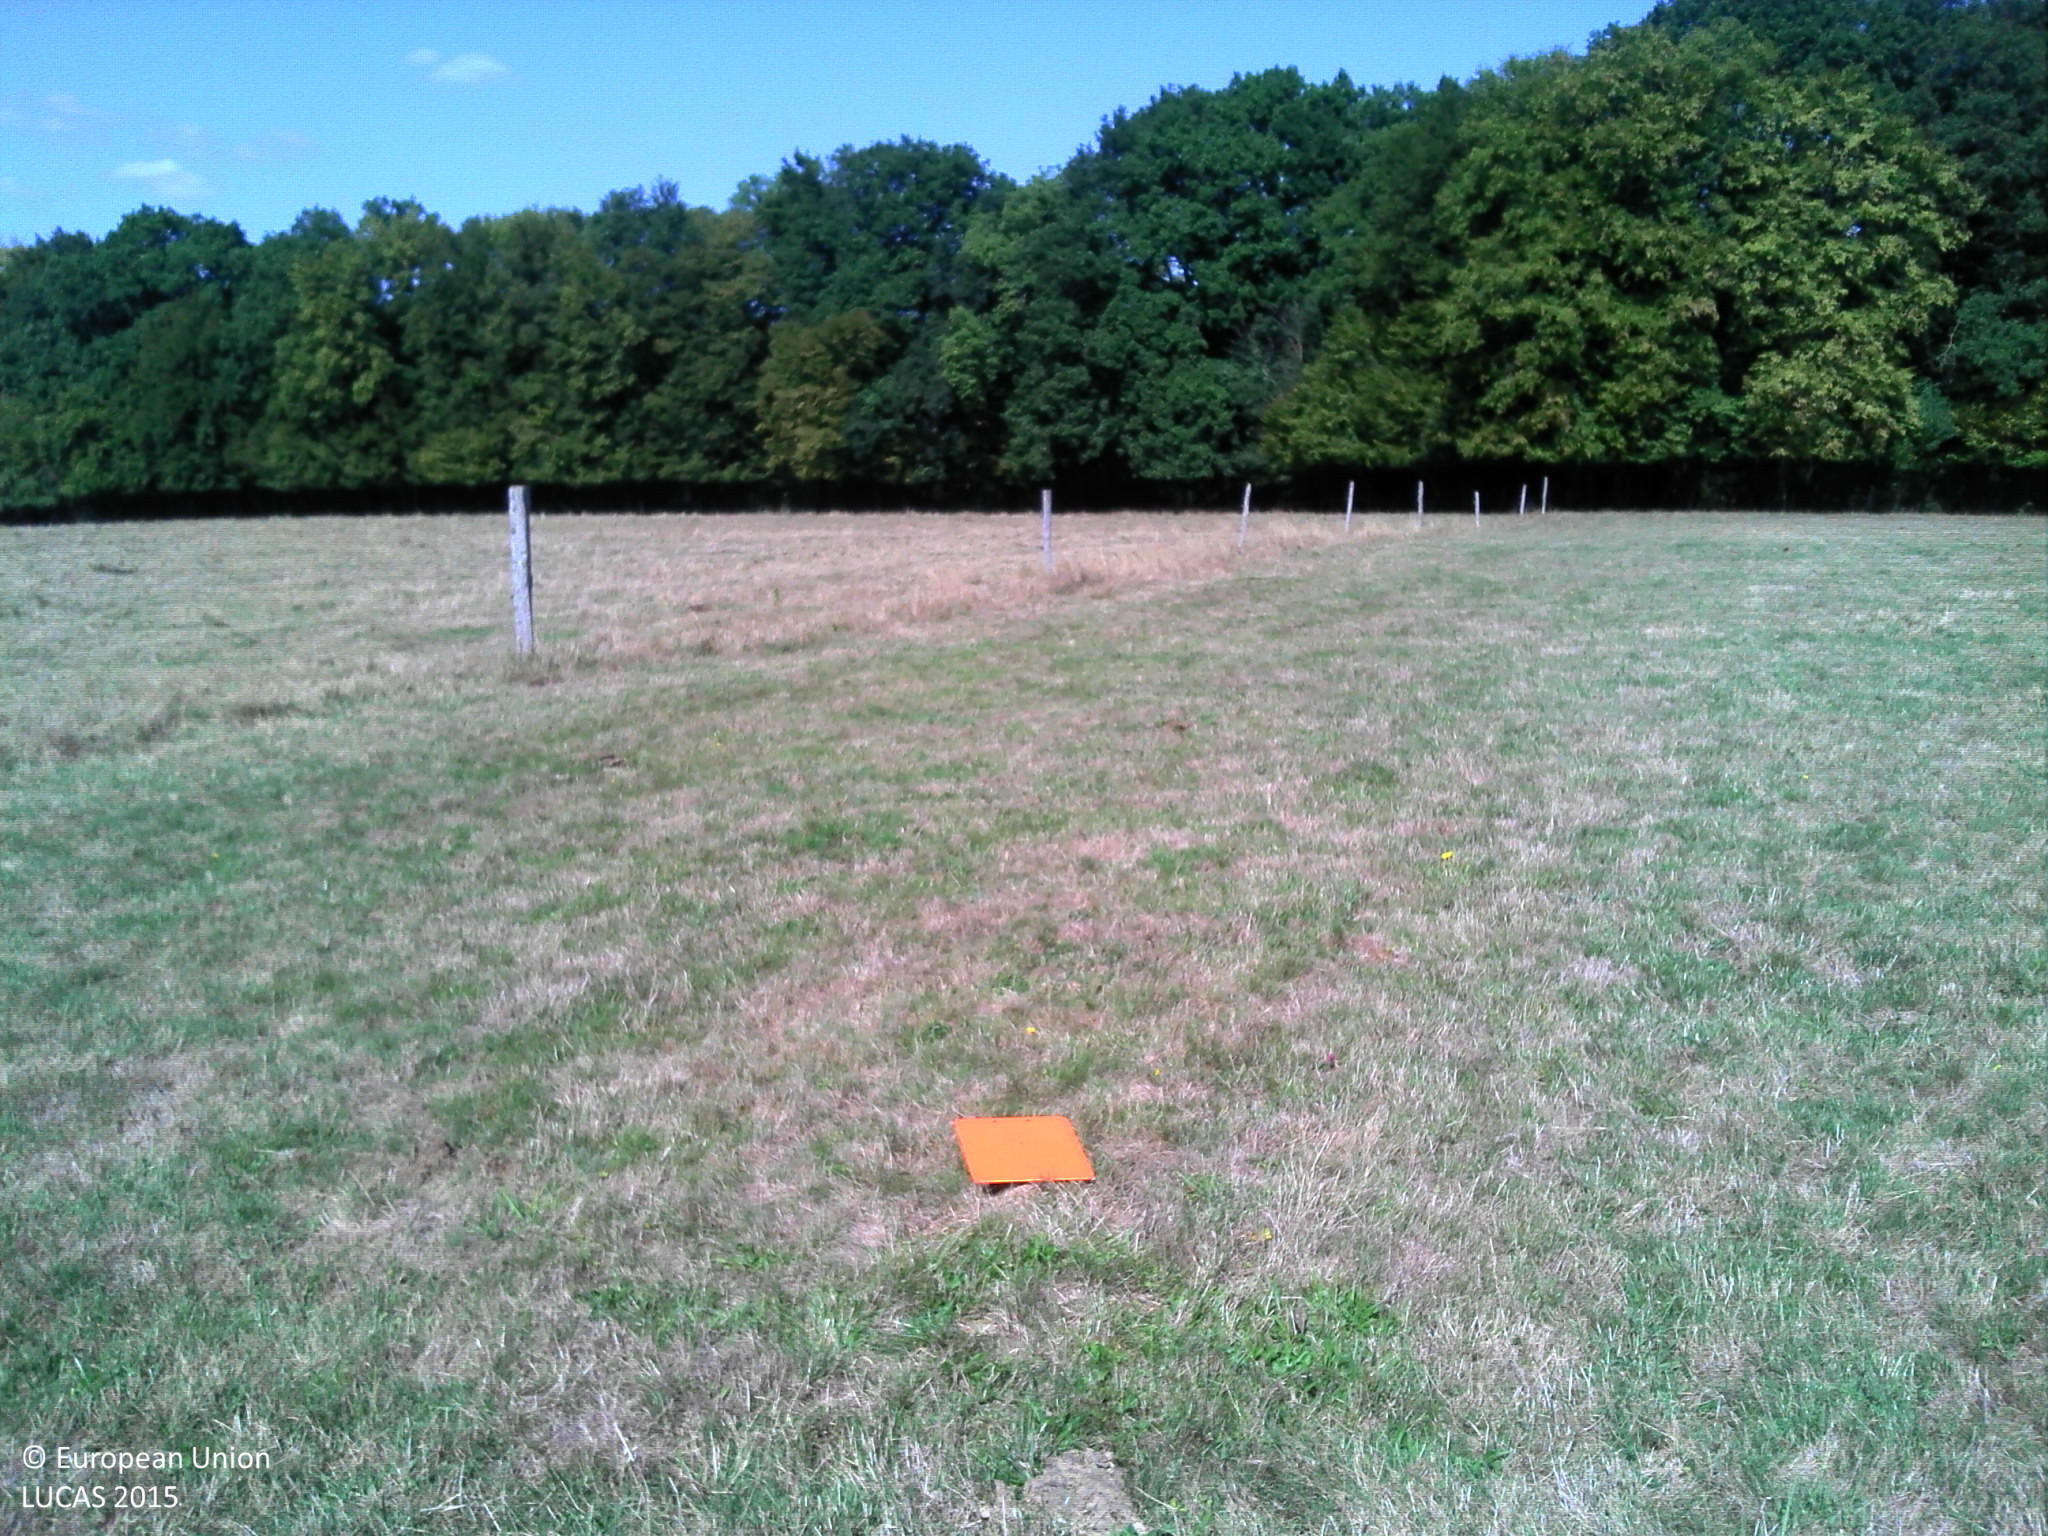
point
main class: Grassland
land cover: Grassland without tree/shrub cover
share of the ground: > 75 %
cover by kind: herbaceous plants 85 %, consolidated bare surface 15 %
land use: Agriculture (excluding fallow land and kitchen gardens)
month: September
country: FR
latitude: 48.6562
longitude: 6.0222
